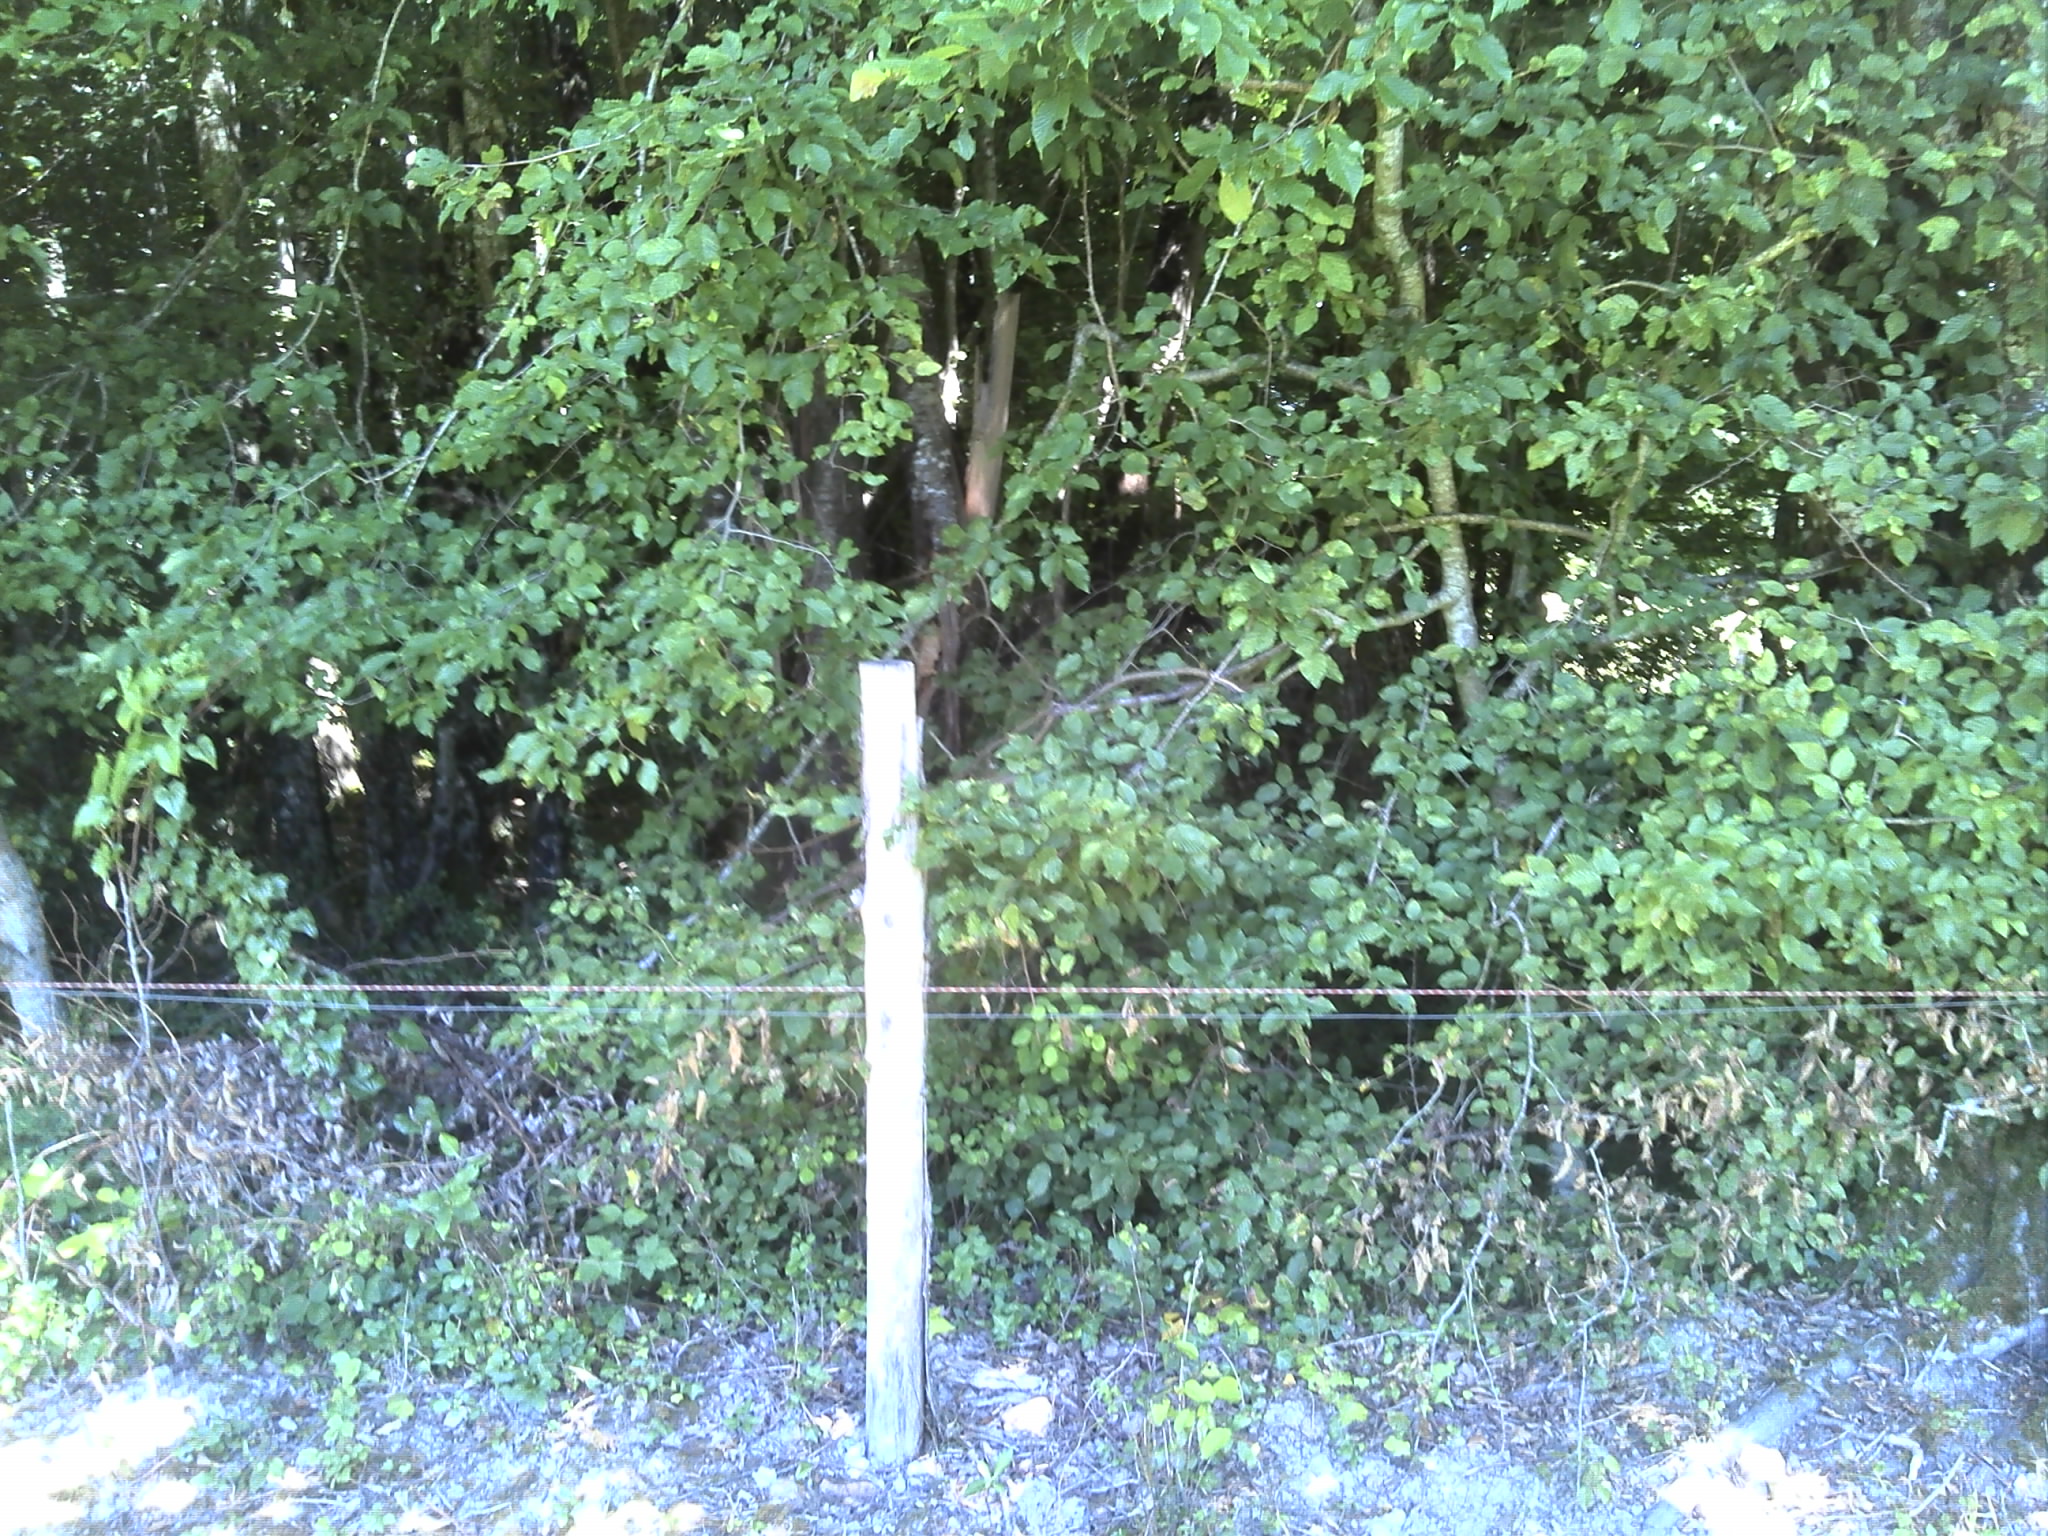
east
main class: Grassland
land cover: Grassland without tree/shrub cover
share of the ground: > 75 %
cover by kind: herbaceous plants 100 %
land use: Agriculture (excluding fallow land and kitchen gardens)
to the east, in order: Grassland without tree/shrub cover; Broadleaved woodland; Fences; Grassland without tree/shrub cover; Fences; Ditches and canals; Grass margins; Paved roads, cycling and walking lanes; Grass margins; Ditches and canals; Managed hedges; Fences; Single bushes/trees; Grassland without tree/shrub cover; Fences; Broadleaved woodland; Fences; Grassland without tree/shrub cover
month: June
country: FR
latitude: 46.3966
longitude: 1.5497
